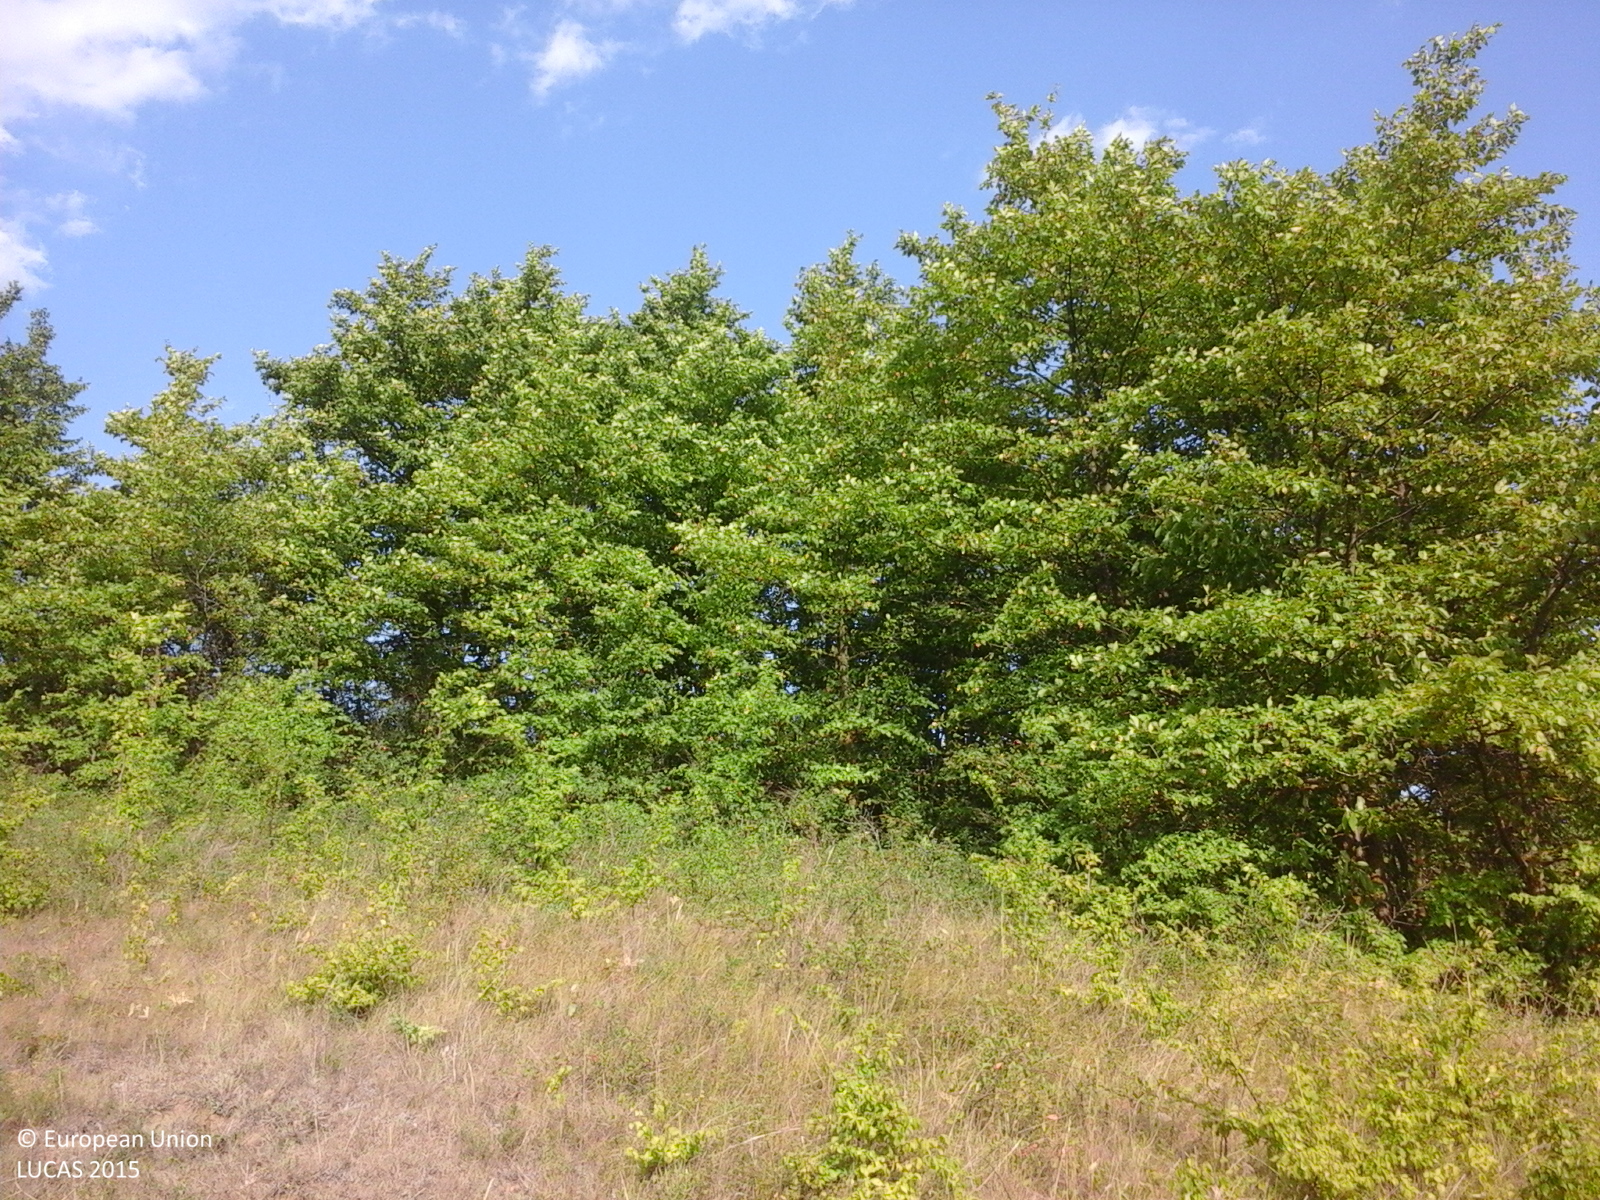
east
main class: Grassland
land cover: Grassland with sparse tree/shrub cover
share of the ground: > 75 %
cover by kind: herbaceous plants 85 %, shrubs 10 %, broadleaved forest trees 5 %
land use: Fallow land
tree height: < 5 m
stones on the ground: < 10 %
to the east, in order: Grassland with sparse tree/shrub cover; Broadleaved woodland; Grassland with sparse tree/shrub cover; Lucerne; Spontaneously vegetated surfaces
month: July
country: RO
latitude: 46.3333
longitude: 27.3700
